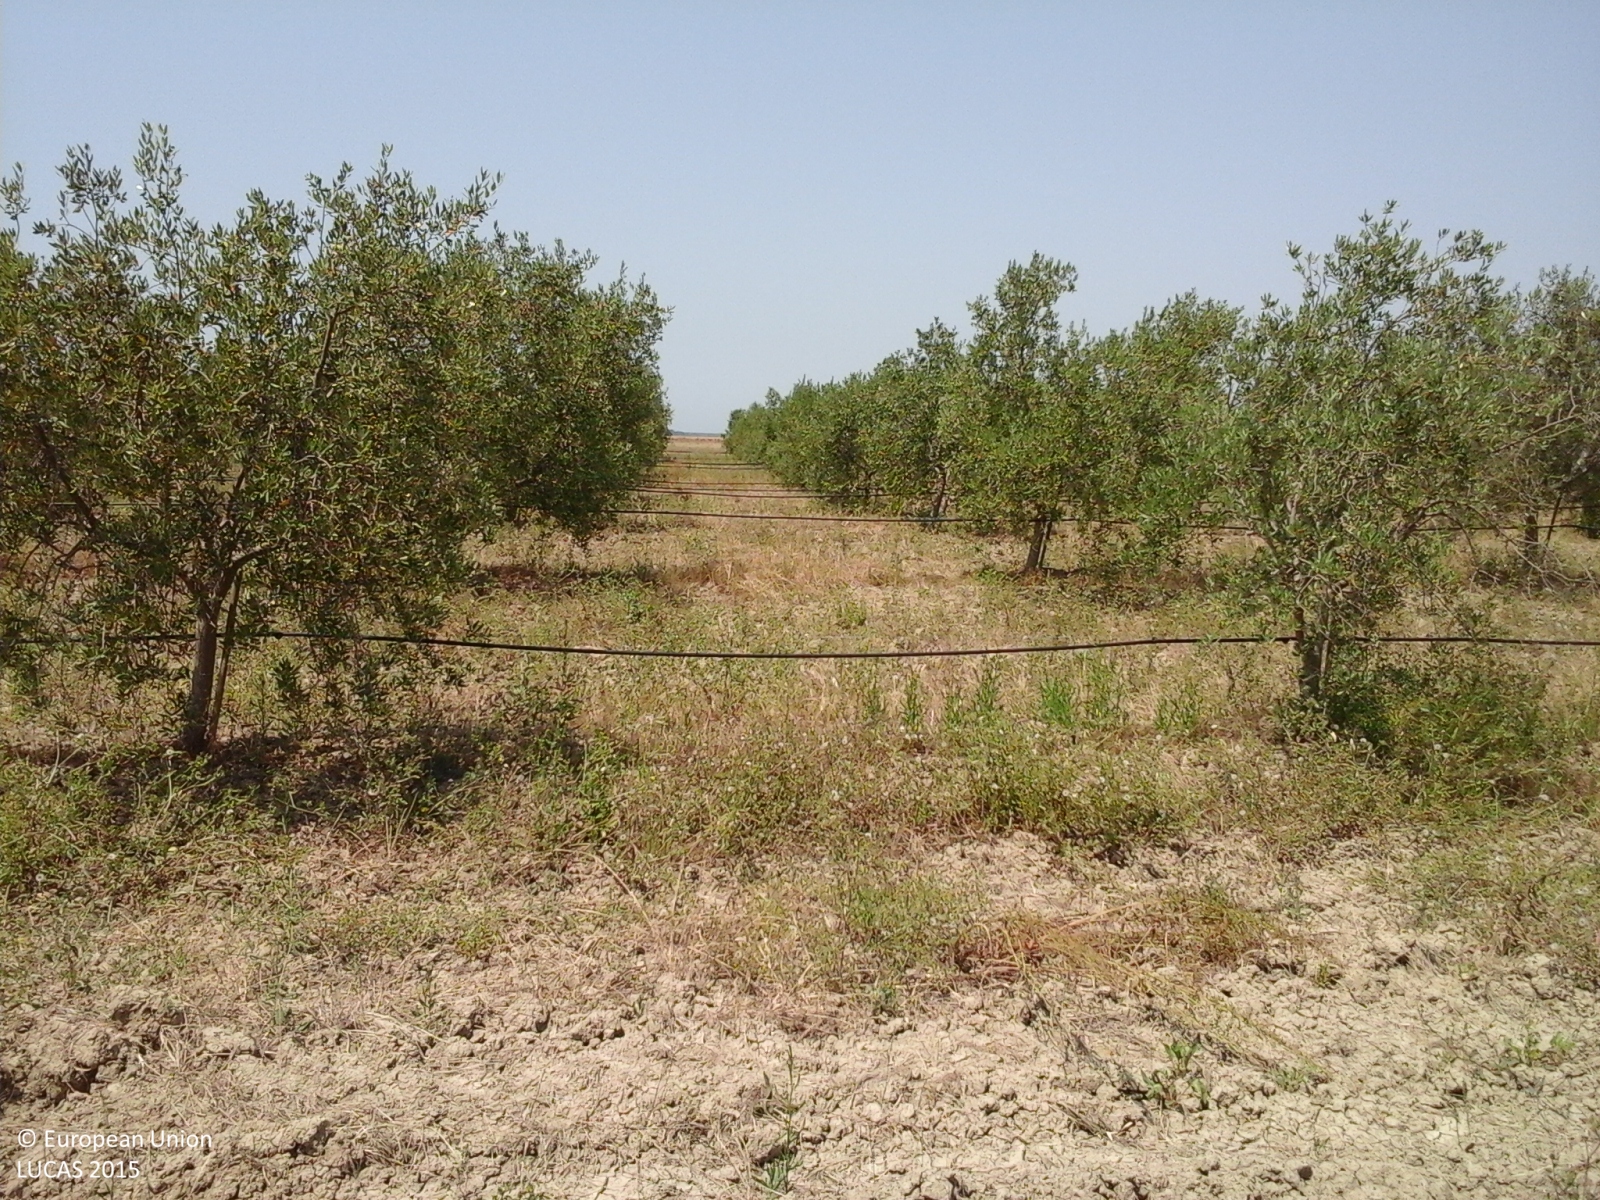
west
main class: Cropland
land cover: Olive groves
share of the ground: 50 - 75 %
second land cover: Grassland without tree/shrub cover
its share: 50 - 75 %
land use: Agriculture (excluding fallow land and kitchen gardens)
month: July
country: IT
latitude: 42.7576
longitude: 10.9865
